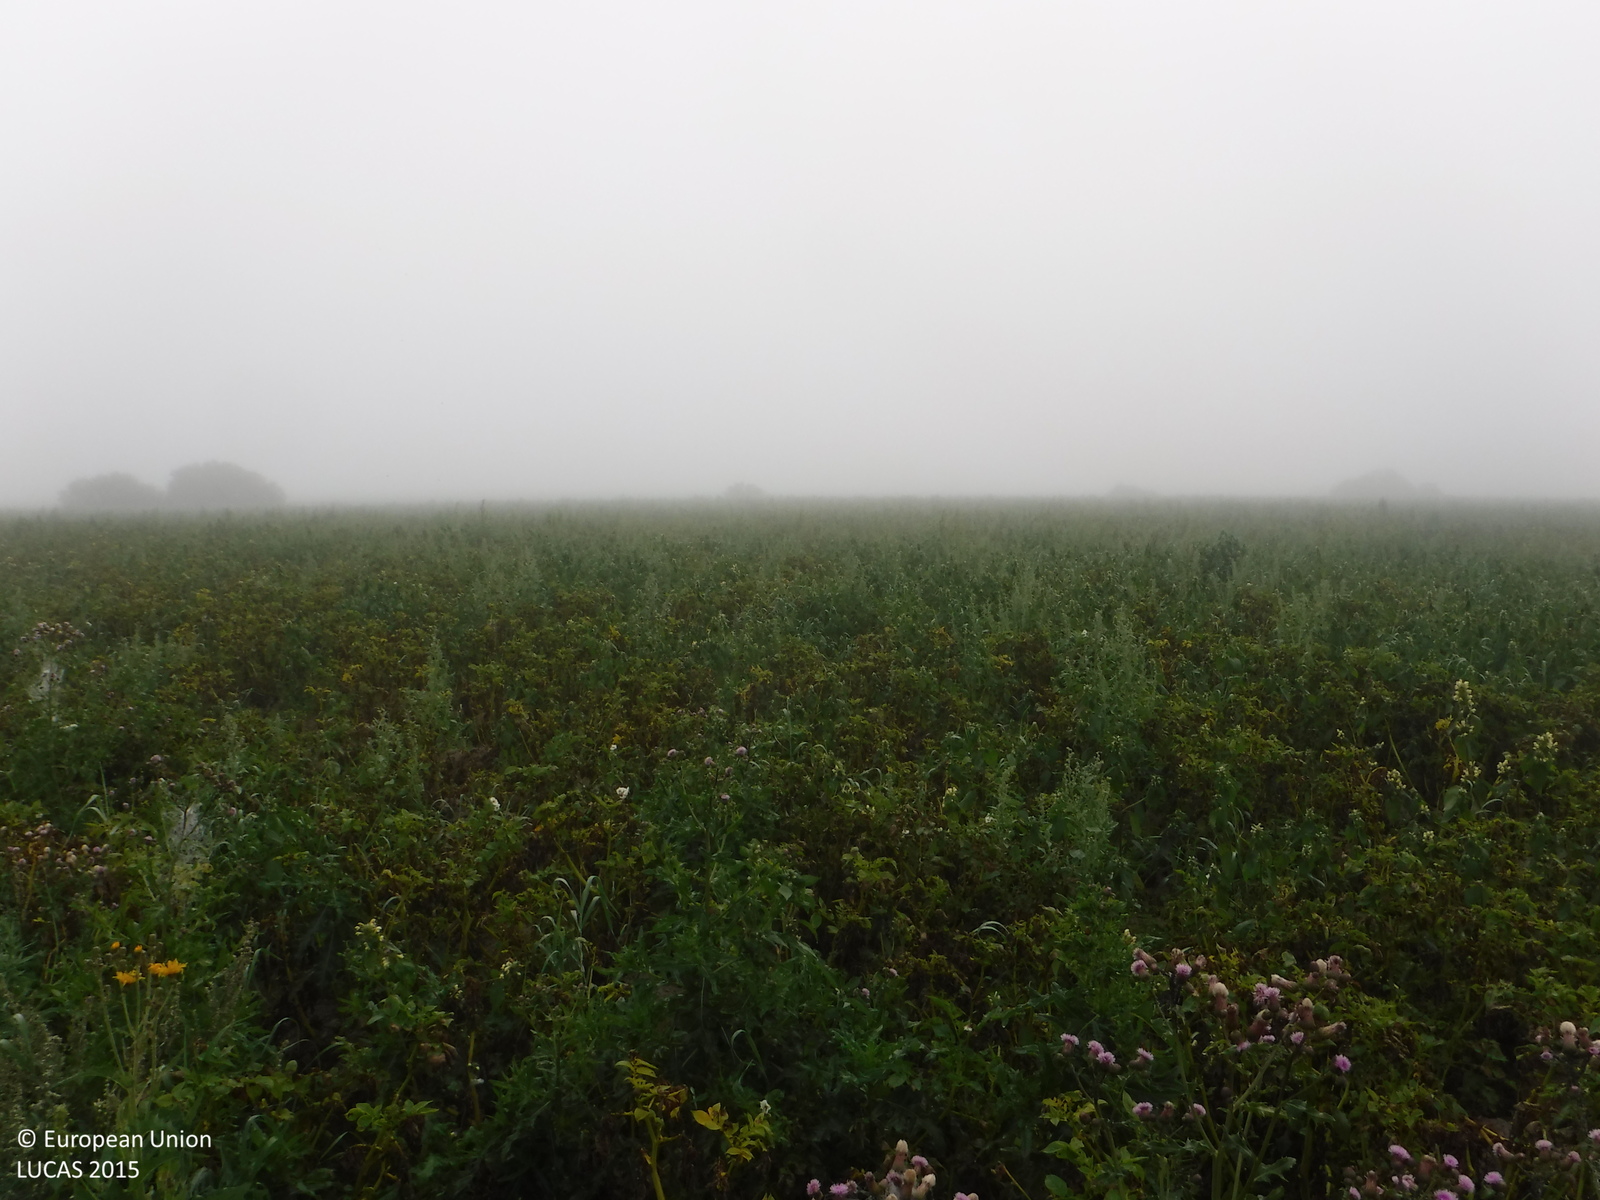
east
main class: Cropland
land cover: Potatoes
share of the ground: 25 - 50 %
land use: Agriculture (excluding fallow land and kitchen gardens)
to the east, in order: Potatoes; Temporary grasslands; Fences; Grassland without tree/shrub cover; Fences; Grassland without tree/shrub cover; Inland fresh running water; Grassland without tree/shrub cover; Fences; Oats
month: August
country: FI
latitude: 61.2065
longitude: 22.5548
